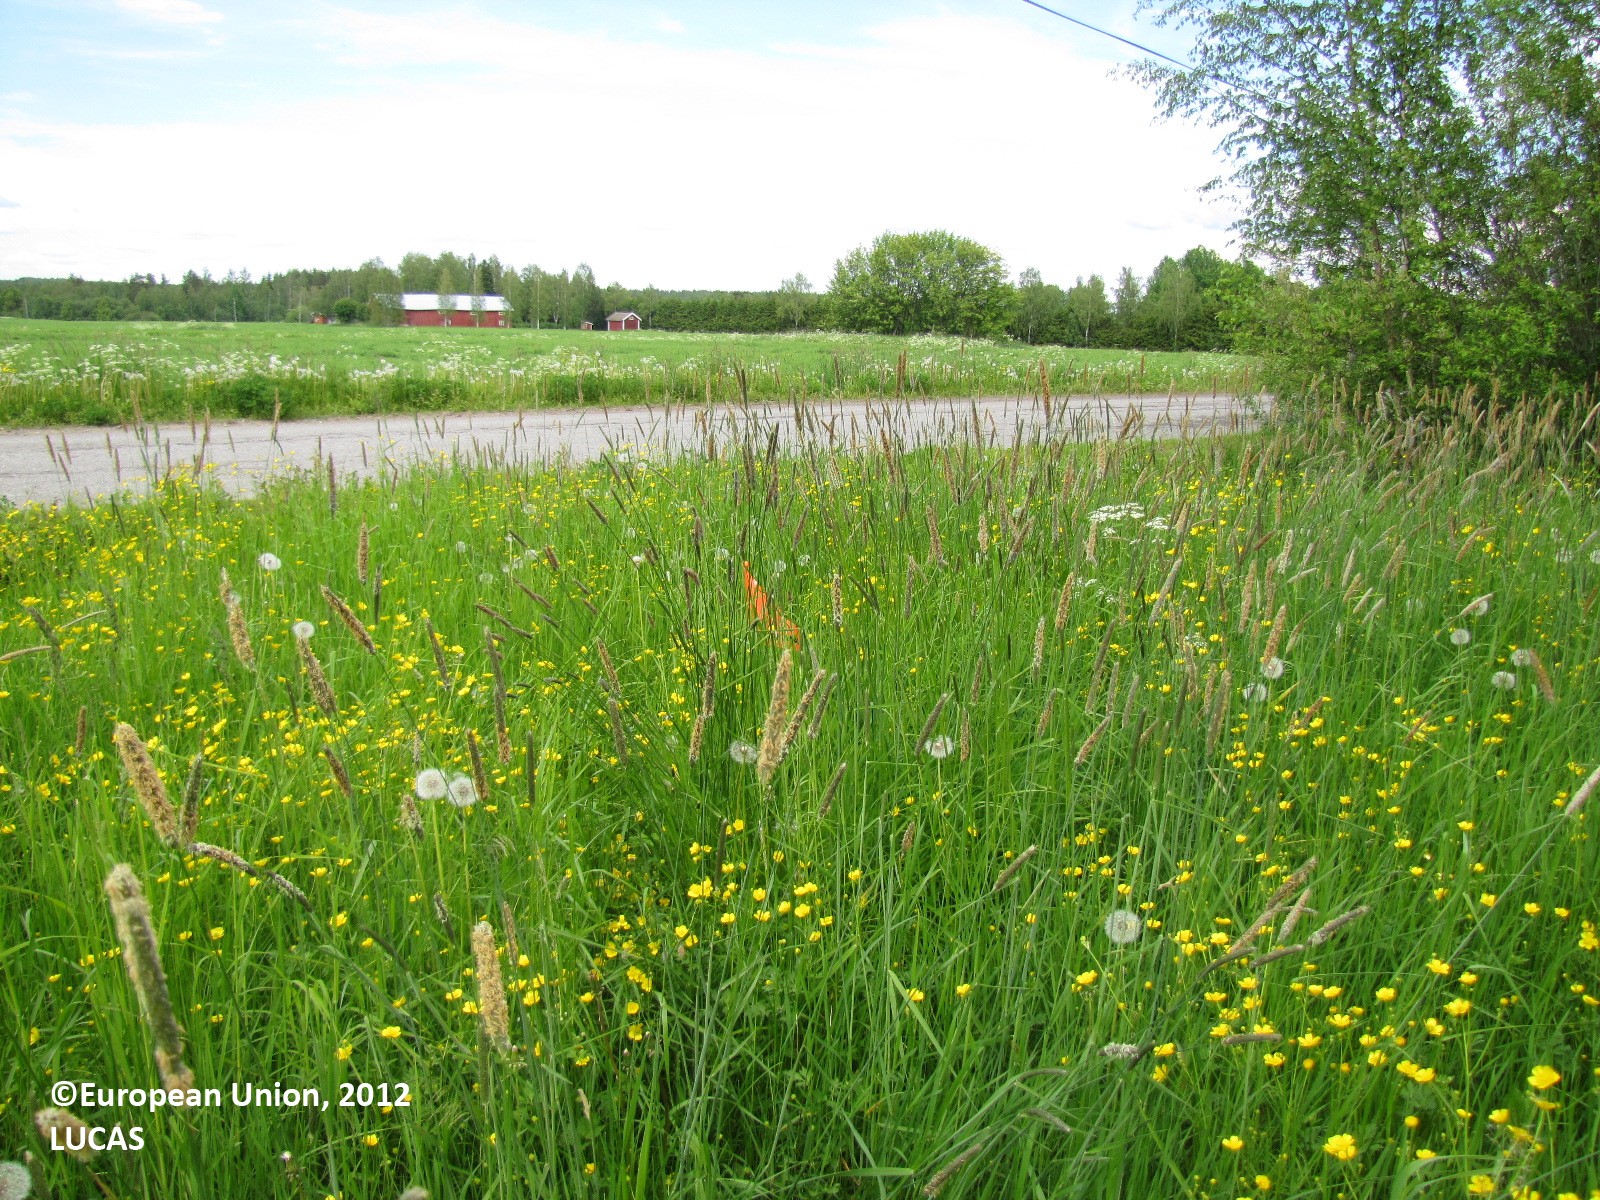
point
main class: Grassland
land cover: Grassland without tree/shrub cover
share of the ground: > 75 %
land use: Residential
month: June
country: FI
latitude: 61.4830
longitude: 24.3086
